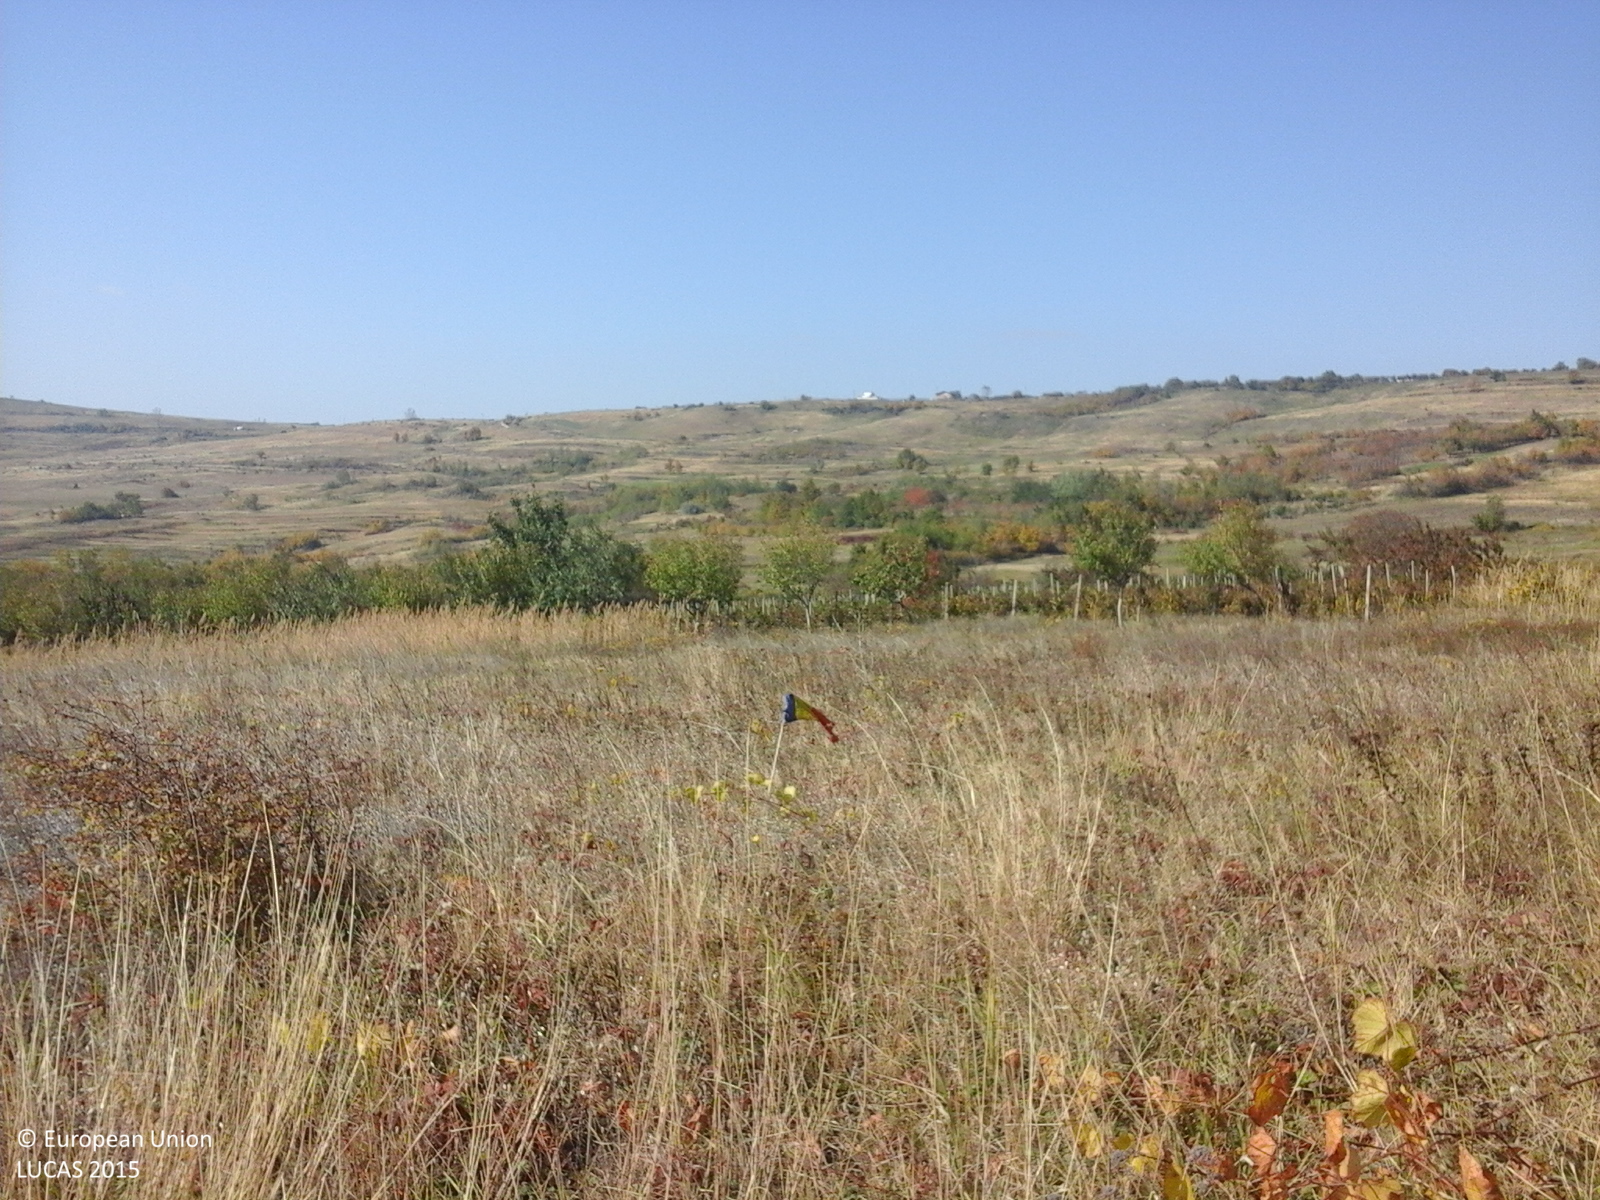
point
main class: Grassland
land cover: Grassland without tree/shrub cover
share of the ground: > 75 %
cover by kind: herbaceous plants 100 %
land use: Agriculture (excluding fallow land and kitchen gardens)
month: October
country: RO
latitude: 45.0855
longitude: 26.4458
